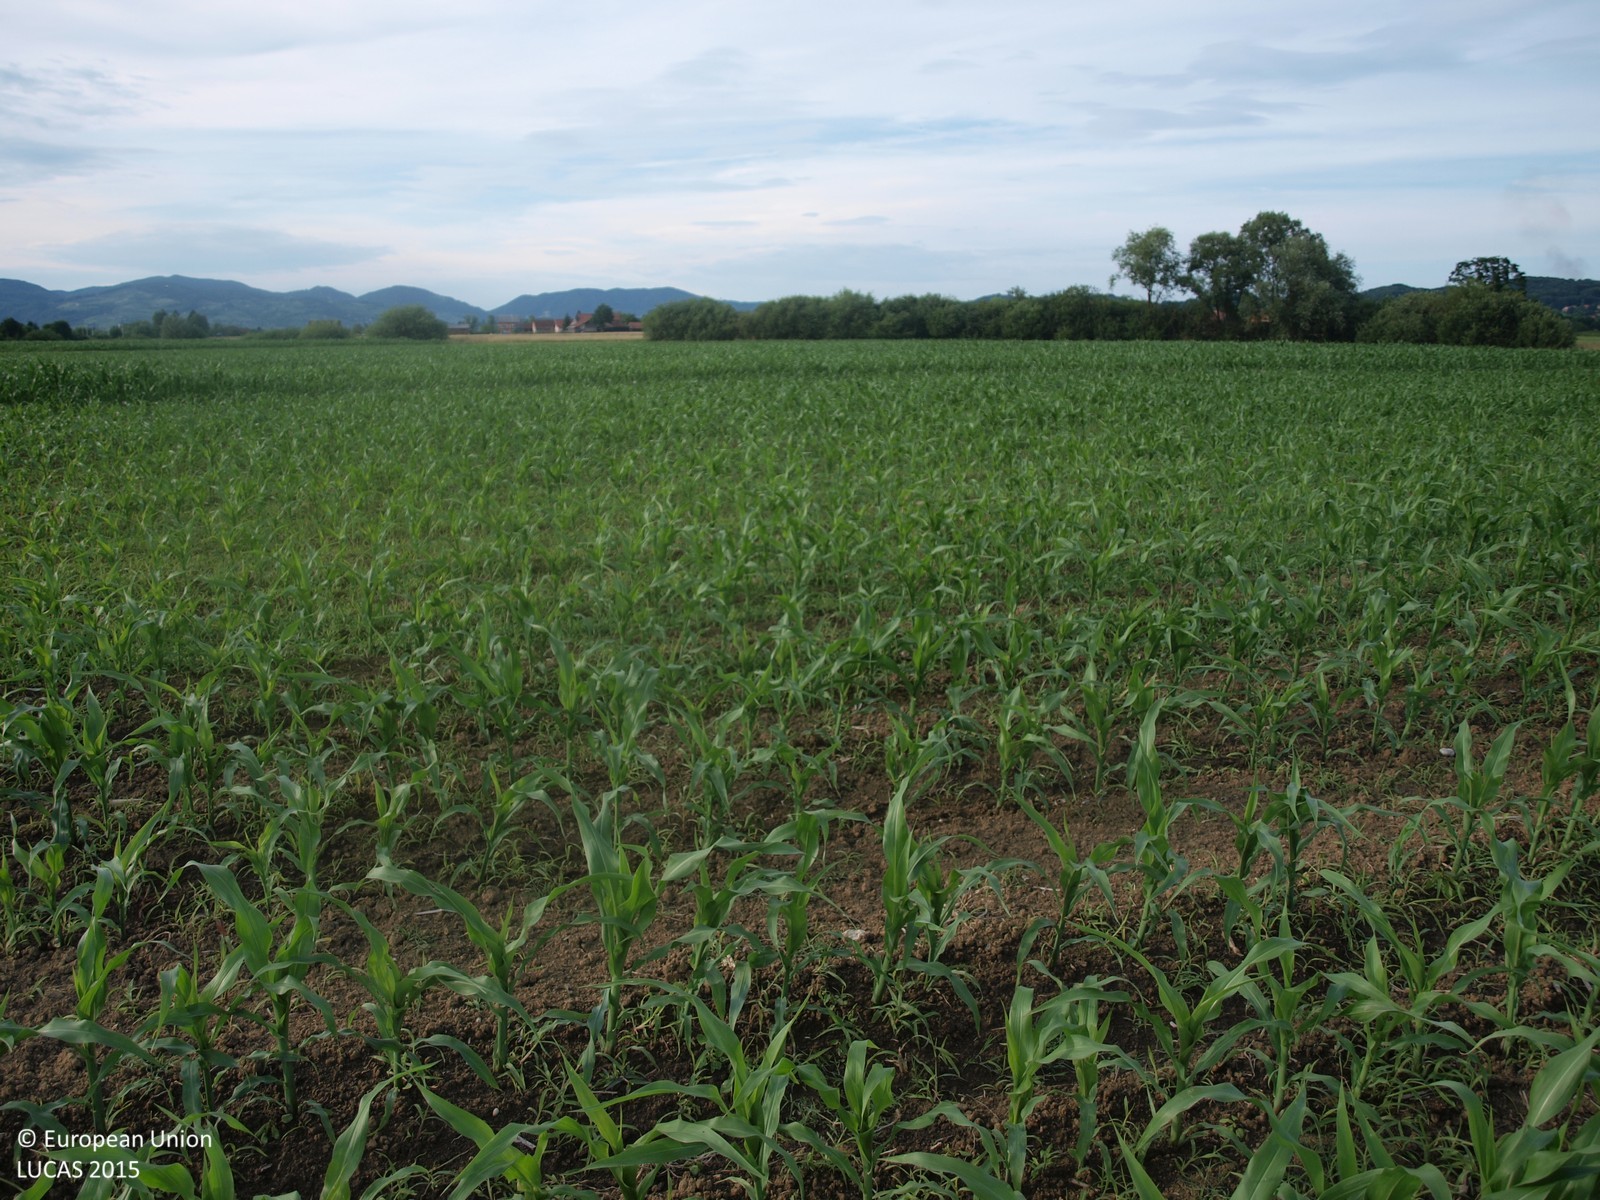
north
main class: Cropland
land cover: Maize
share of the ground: > 75 %
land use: Agriculture (excluding fallow land and kitchen gardens)
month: June
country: HR
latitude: 45.9637
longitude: 15.7142
